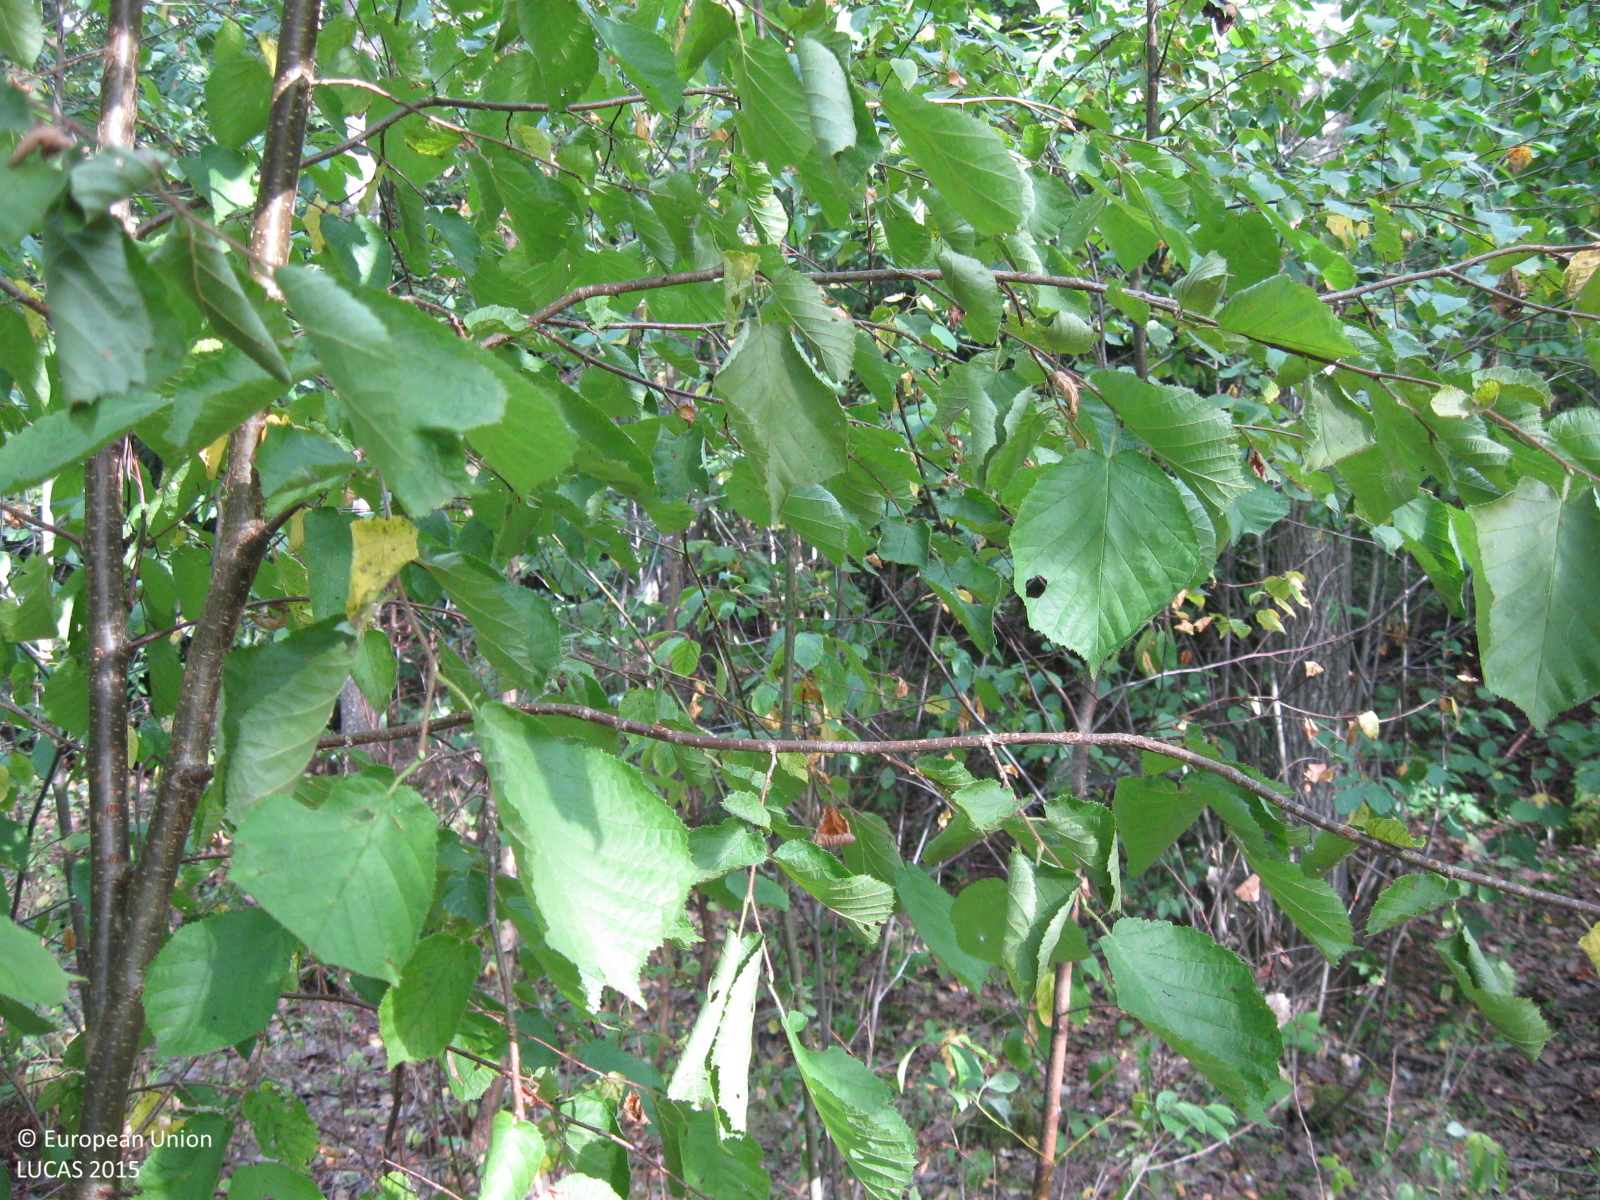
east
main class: Woodland
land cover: Broadleaved woodland
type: non-riverine alder, birch or aspen forest
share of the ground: > 75 %
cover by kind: broadleaved forest trees 85 %, coniferous forest trees 10 %, herbaceous plants 5 %
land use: Forestry
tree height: > 5 m
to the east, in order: Broadleaved woodland; Spruce dominated mixed woodland; Broadleaved woodland; Ditches and canals; Broadleaved woodland; Tracks; Common wheat
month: August
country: LT
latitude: 55.2604
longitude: 22.8927
